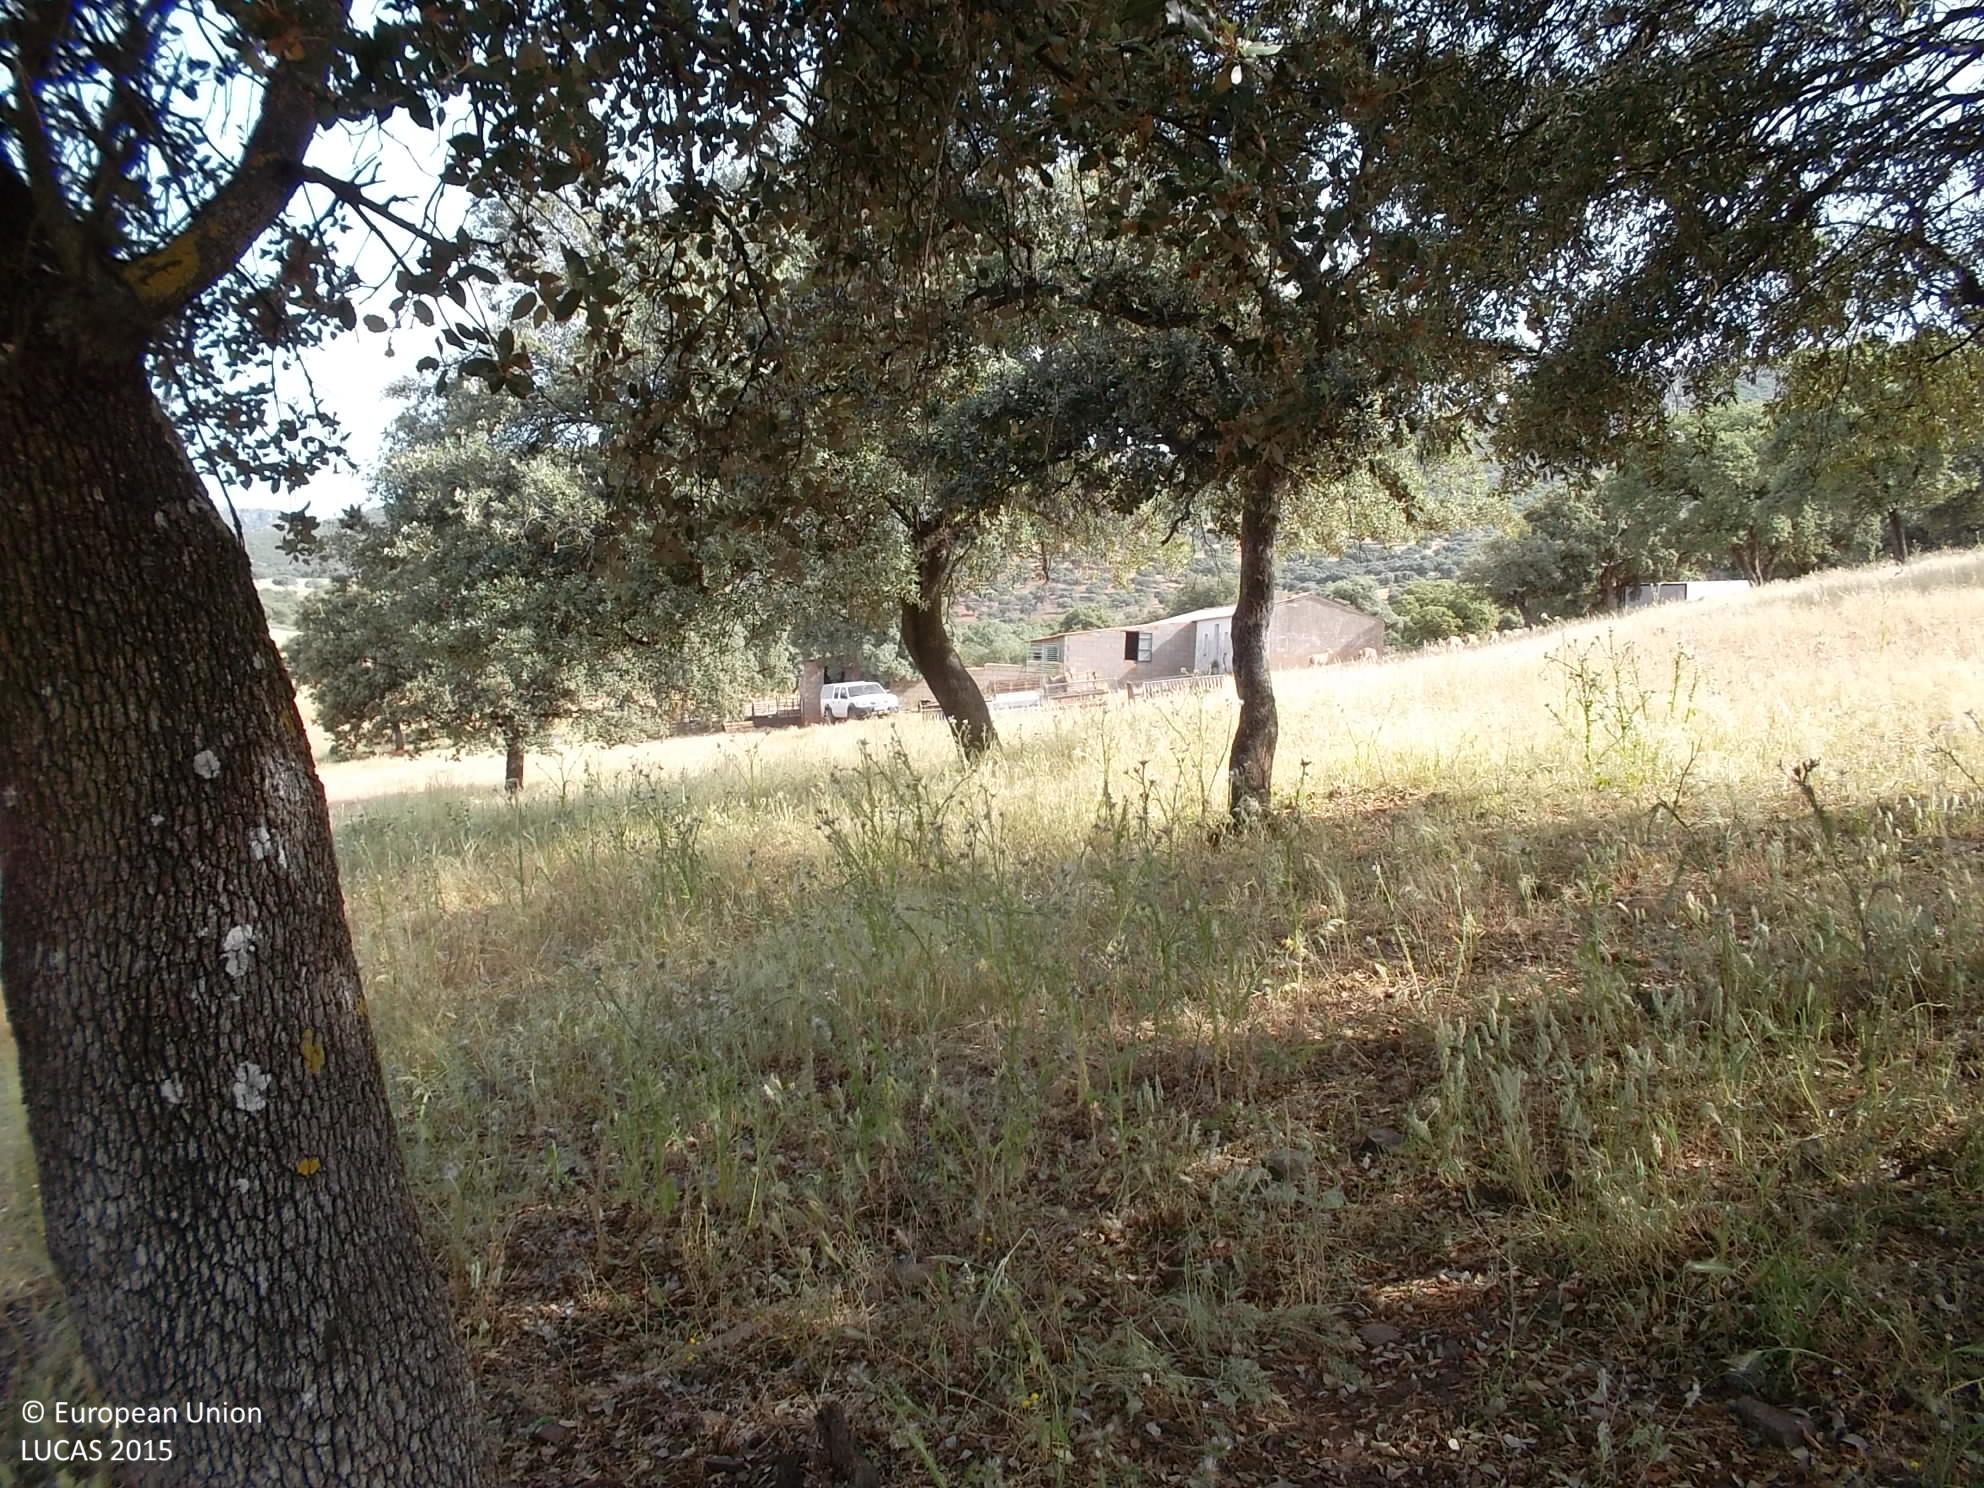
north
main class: Woodland
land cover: Broadleaved woodland
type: broadleaved evergreen forest
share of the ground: 25 - 50 %
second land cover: Spontaneously vegetated surfaces
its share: > 75 %
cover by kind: herbaceous plants 60 %, broadleaved forest trees 40 %
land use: Forestry
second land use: Agriculture (excluding fallow land and kitchen gardens)
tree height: > 5 m
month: May
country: ES
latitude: 38.6007
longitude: -4.7110
